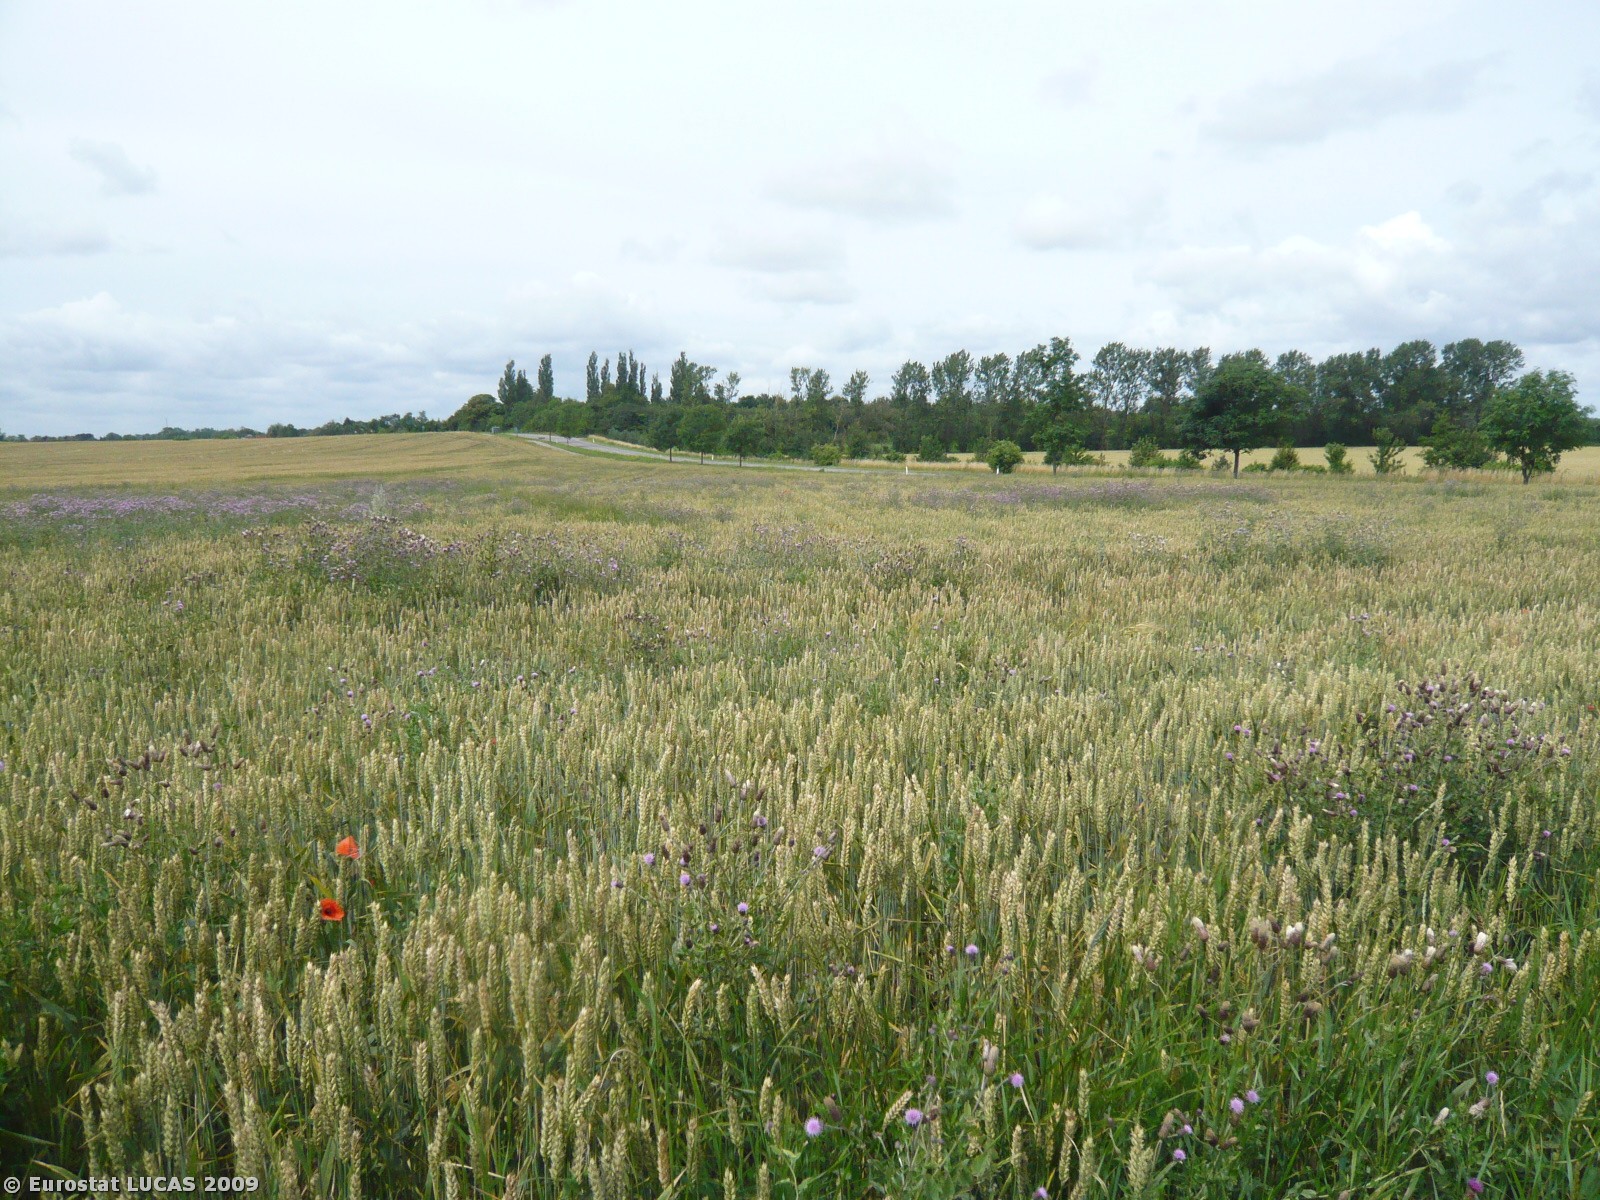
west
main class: Cropland
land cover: Common wheat
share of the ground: > 75 %
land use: Agriculture (excluding fallow land and kitchen gardens)
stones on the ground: < 10 %
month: July
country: DK
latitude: 55.6821
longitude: 12.2724
